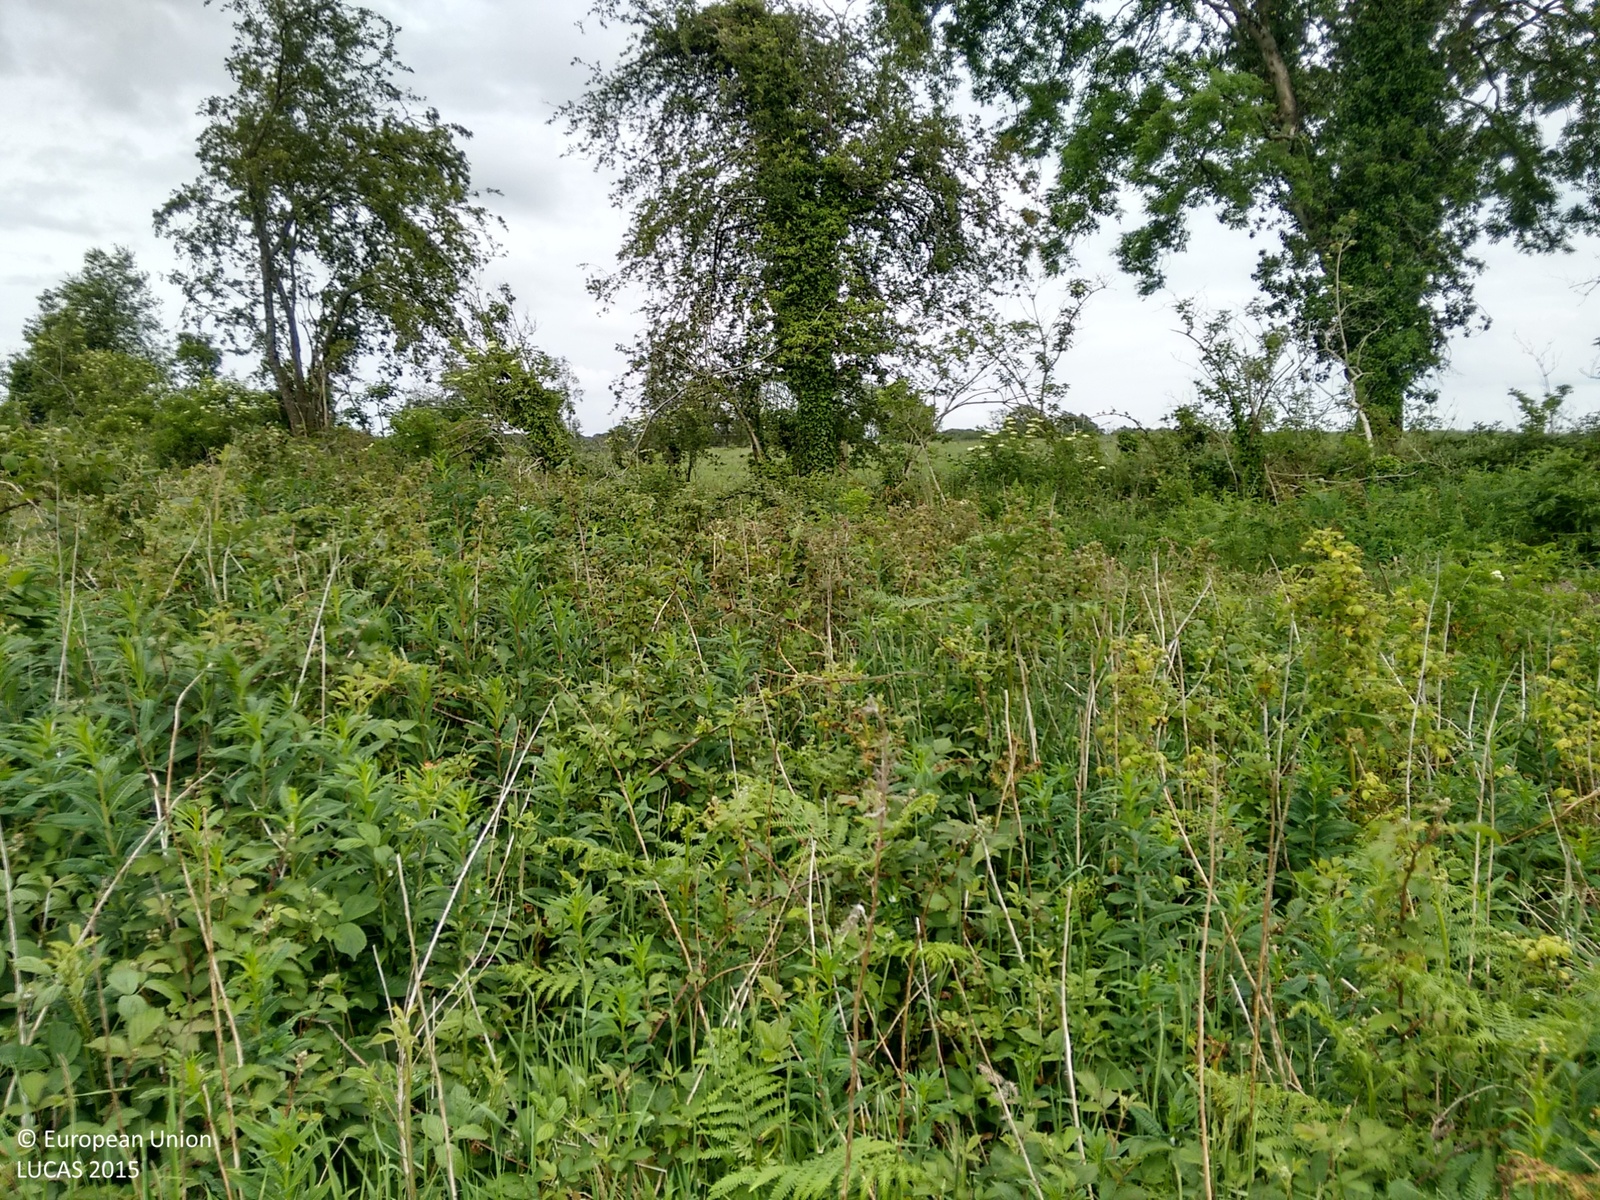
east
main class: Shrubland
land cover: Shrubland without tree cover
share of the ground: > 75 %
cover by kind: herbaceous plants 80 %, shrubs 20 %
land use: Forestry
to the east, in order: Shrubland without tree cover; Ponds and wetlands; Abandoned hedges; Fences; Grassland without tree/shrub cover; Fences; Managed hedges
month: June
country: IE
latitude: 53.7468
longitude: -6.7689
